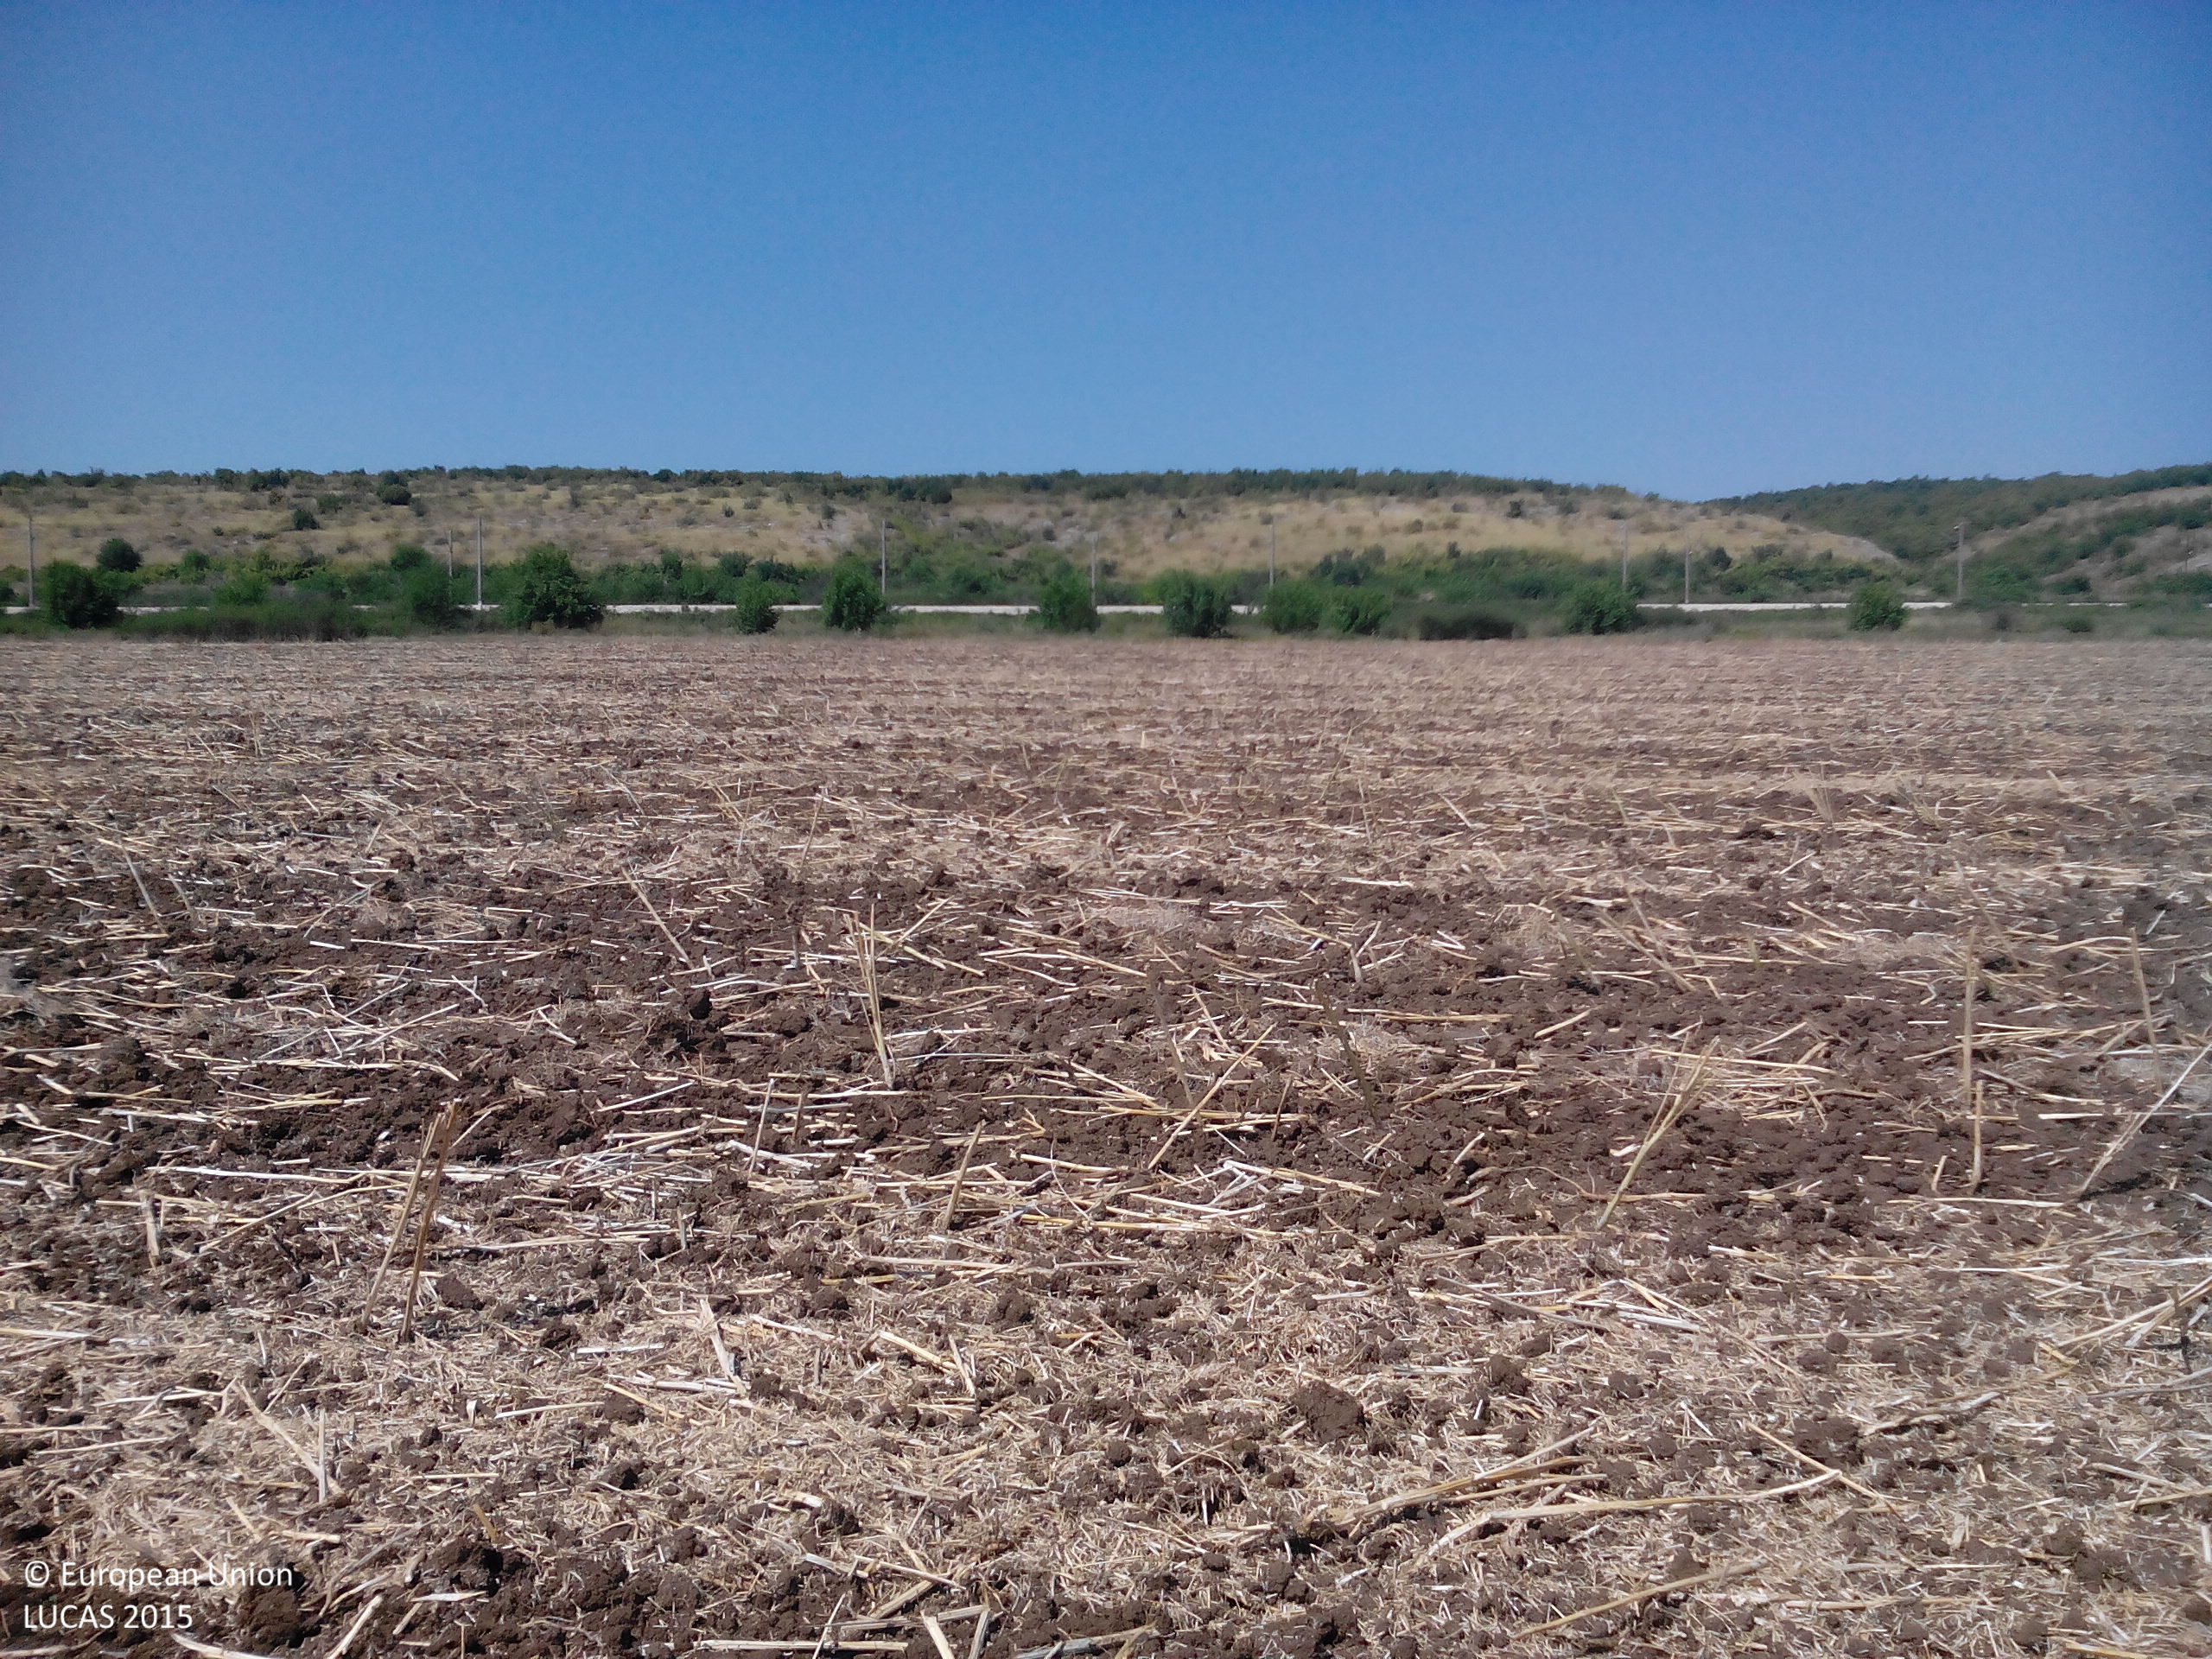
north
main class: Cropland
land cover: Rape and turnip rape
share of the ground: < 10 %
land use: Agriculture (excluding fallow land and kitchen gardens)
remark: Harvested field
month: July
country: BG
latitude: 43.2886
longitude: 24.1150
